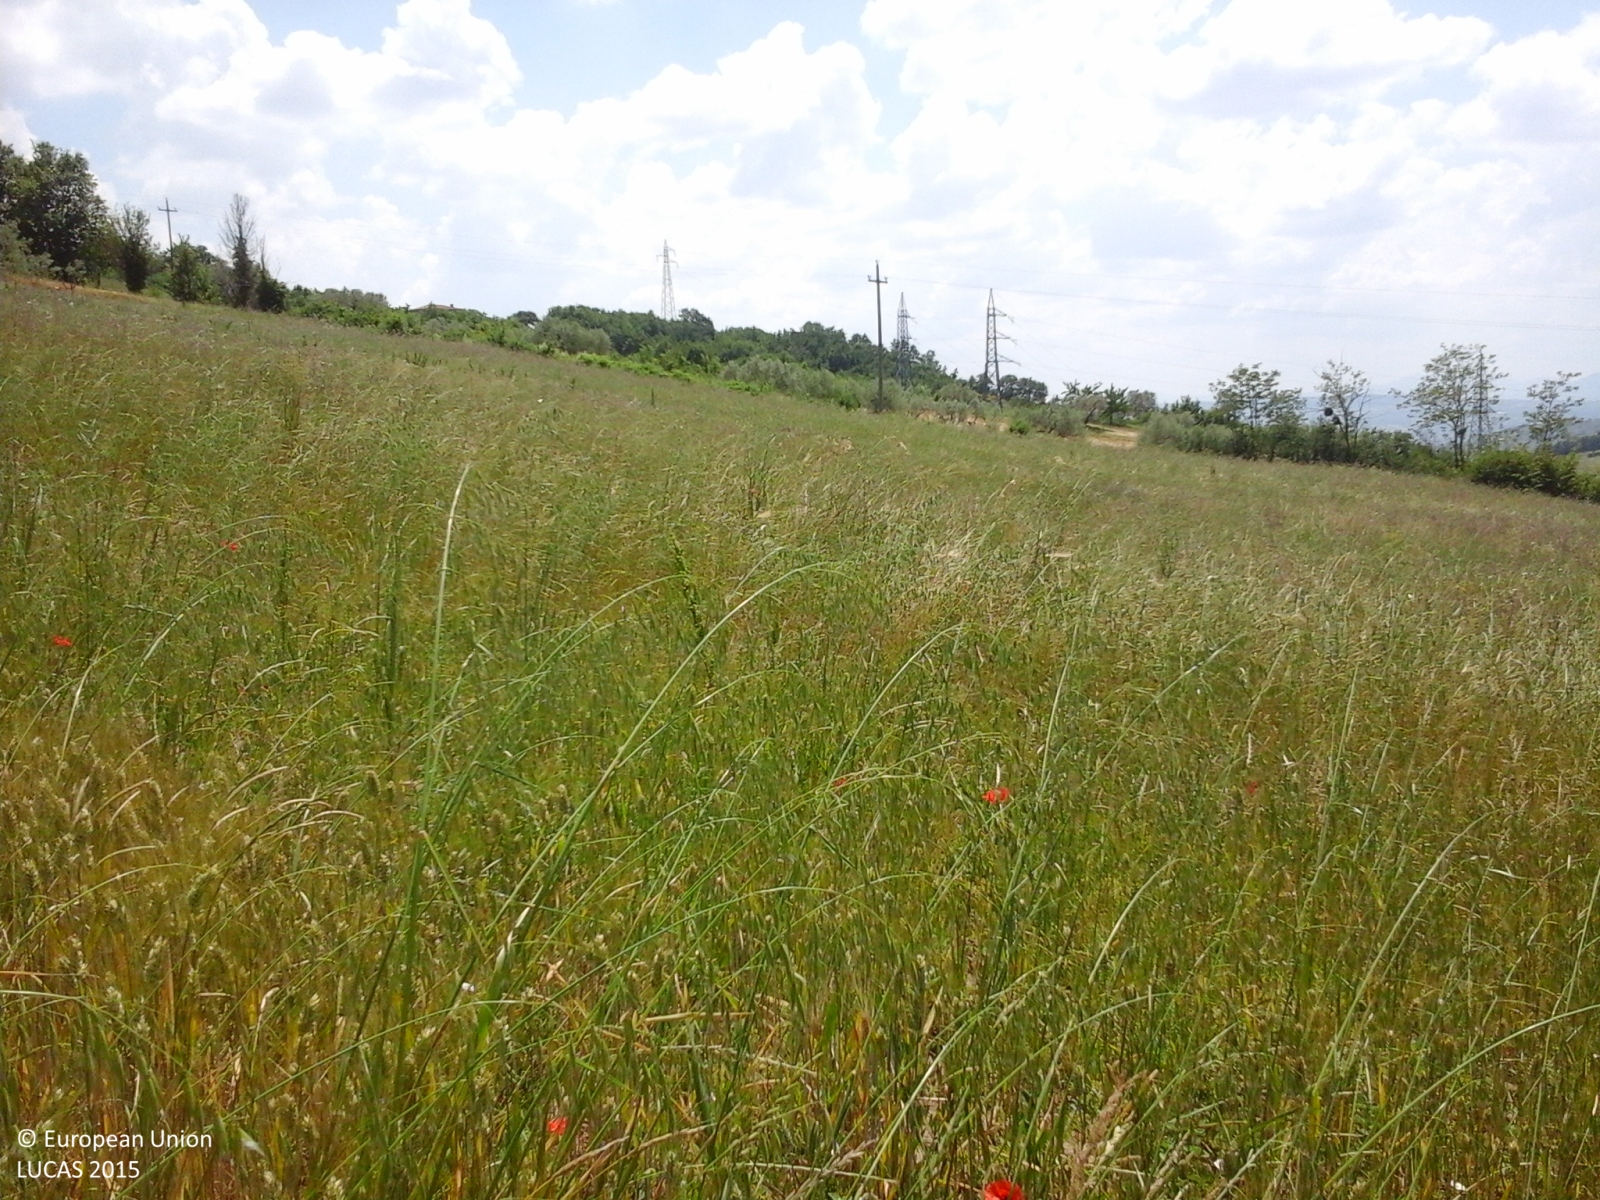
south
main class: Cropland
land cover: Mixed cereals for fodder
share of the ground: > 75 %
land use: Agriculture (excluding fallow land and kitchen gardens)
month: June
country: IT
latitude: 41.1488
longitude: 15.1167
